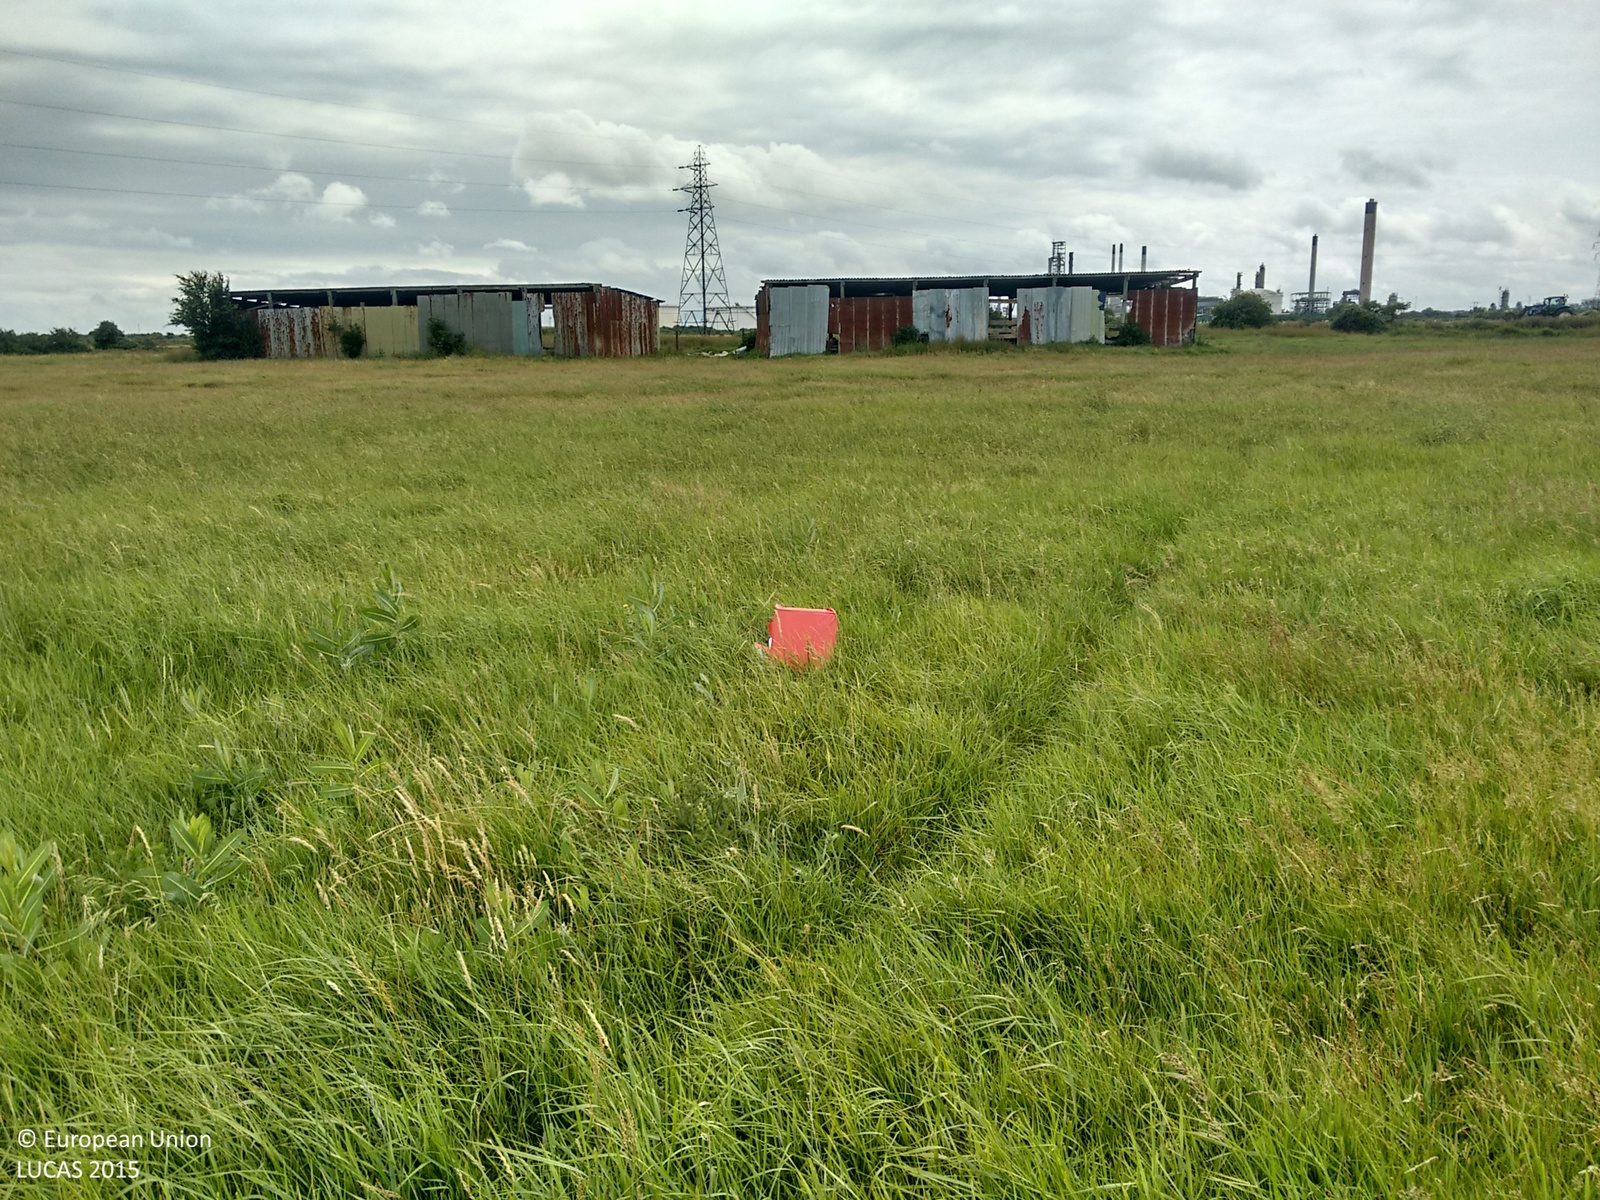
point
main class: Grassland
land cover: Grassland without tree/shrub cover
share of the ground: > 75 %
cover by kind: herbaceous plants 100 %
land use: Agriculture (excluding fallow land and kitchen gardens)
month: July
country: GB
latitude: 51.5252
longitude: 0.5025
